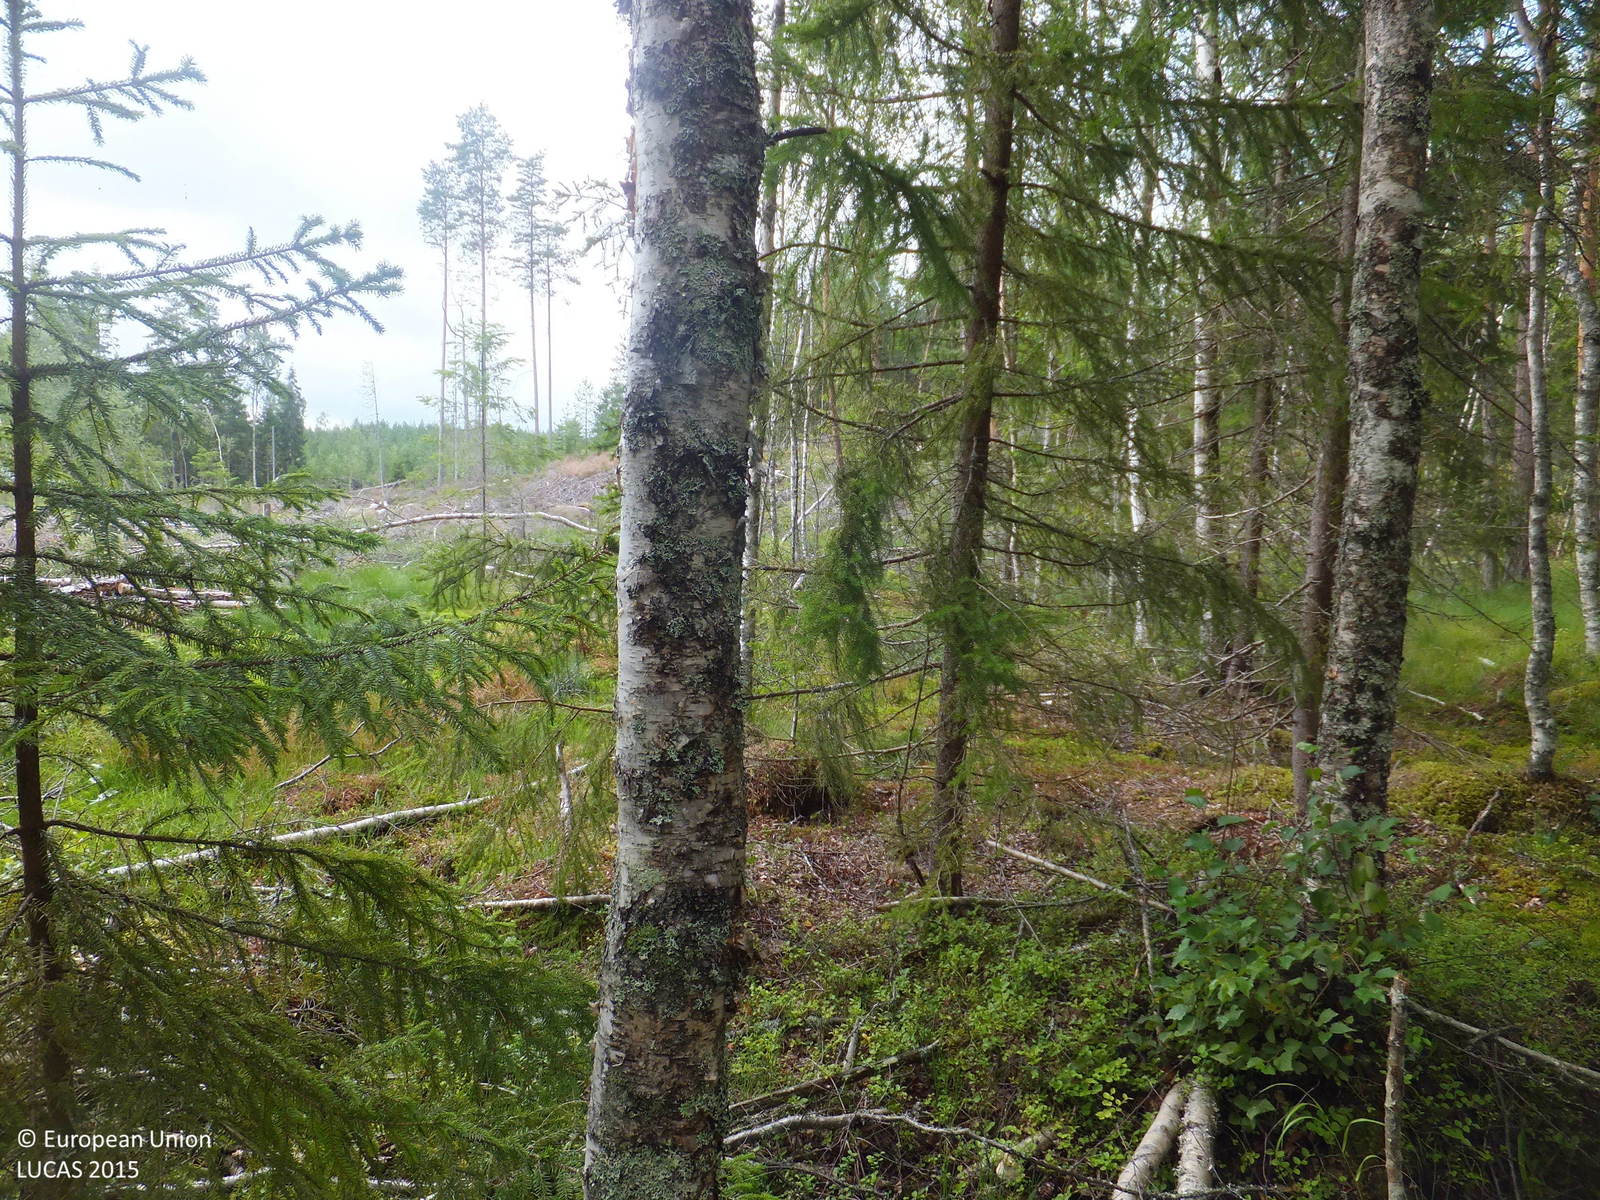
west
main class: Woodland
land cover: Other mixed woodland
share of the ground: > 75 %
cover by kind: broadleaved forest trees 50 %, coniferous forest trees 30 %, shrubs 10 %, herbaceous plants 5 %, lichens and mosses 5 %
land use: Forestry
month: July
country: FI
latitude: 63.3098
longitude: 22.1170
